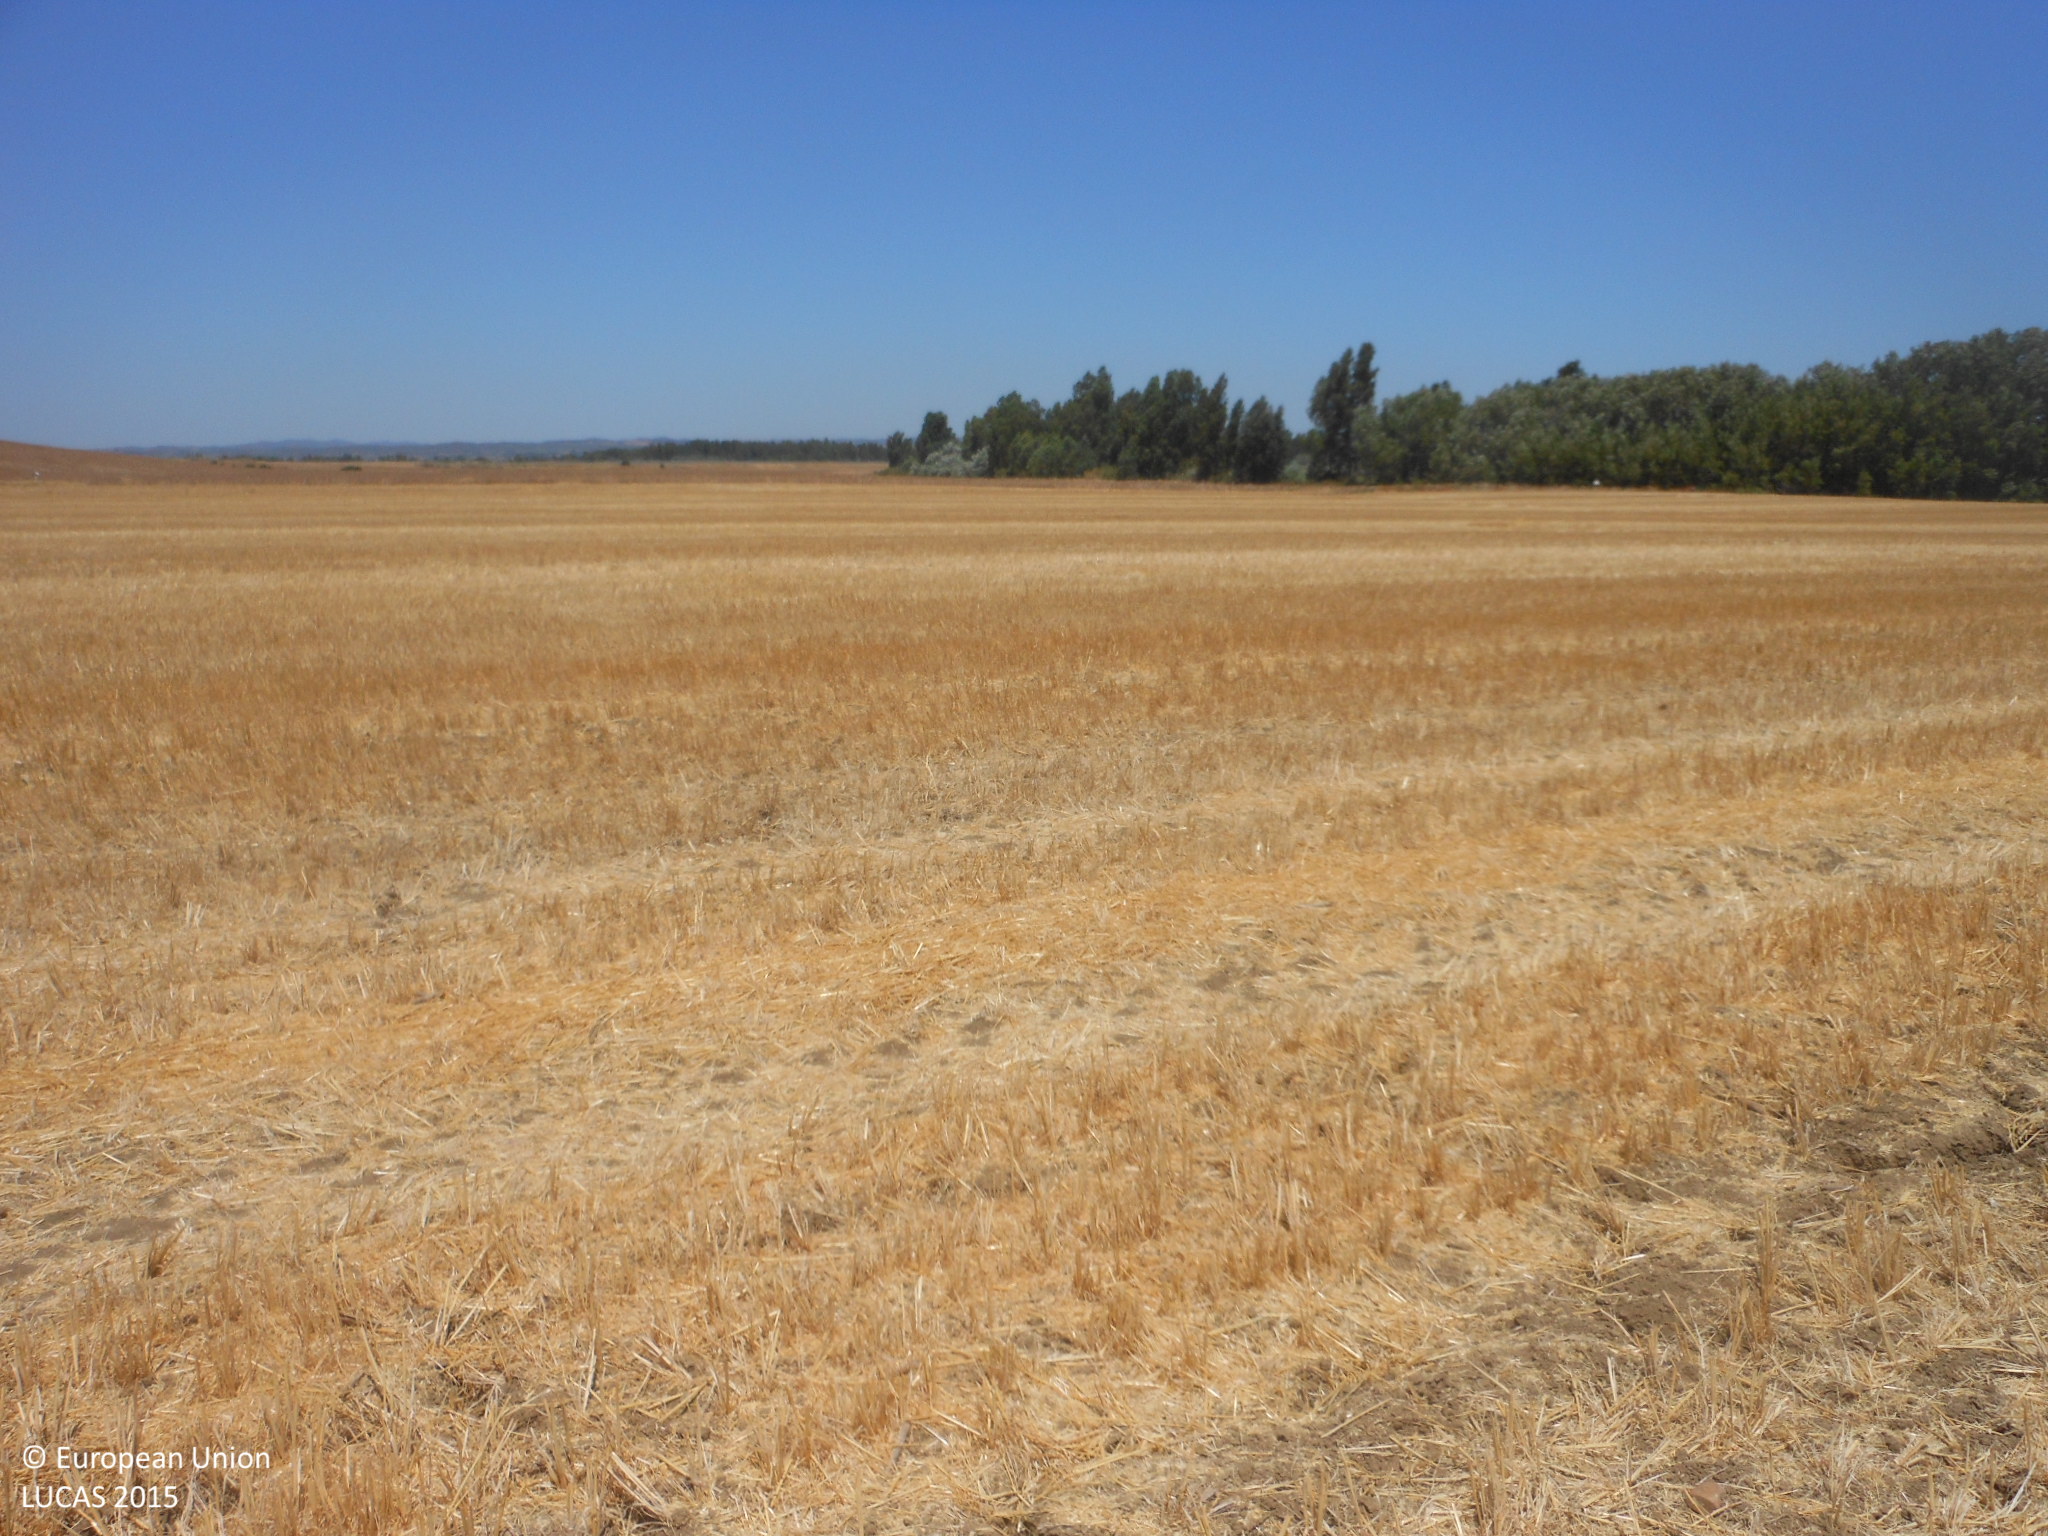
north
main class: Cropland
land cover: Barley
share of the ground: < 10 %
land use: Agriculture (excluding fallow land and kitchen gardens)
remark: Harvested field
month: July
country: ES
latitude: 37.5556
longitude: -5.6082
